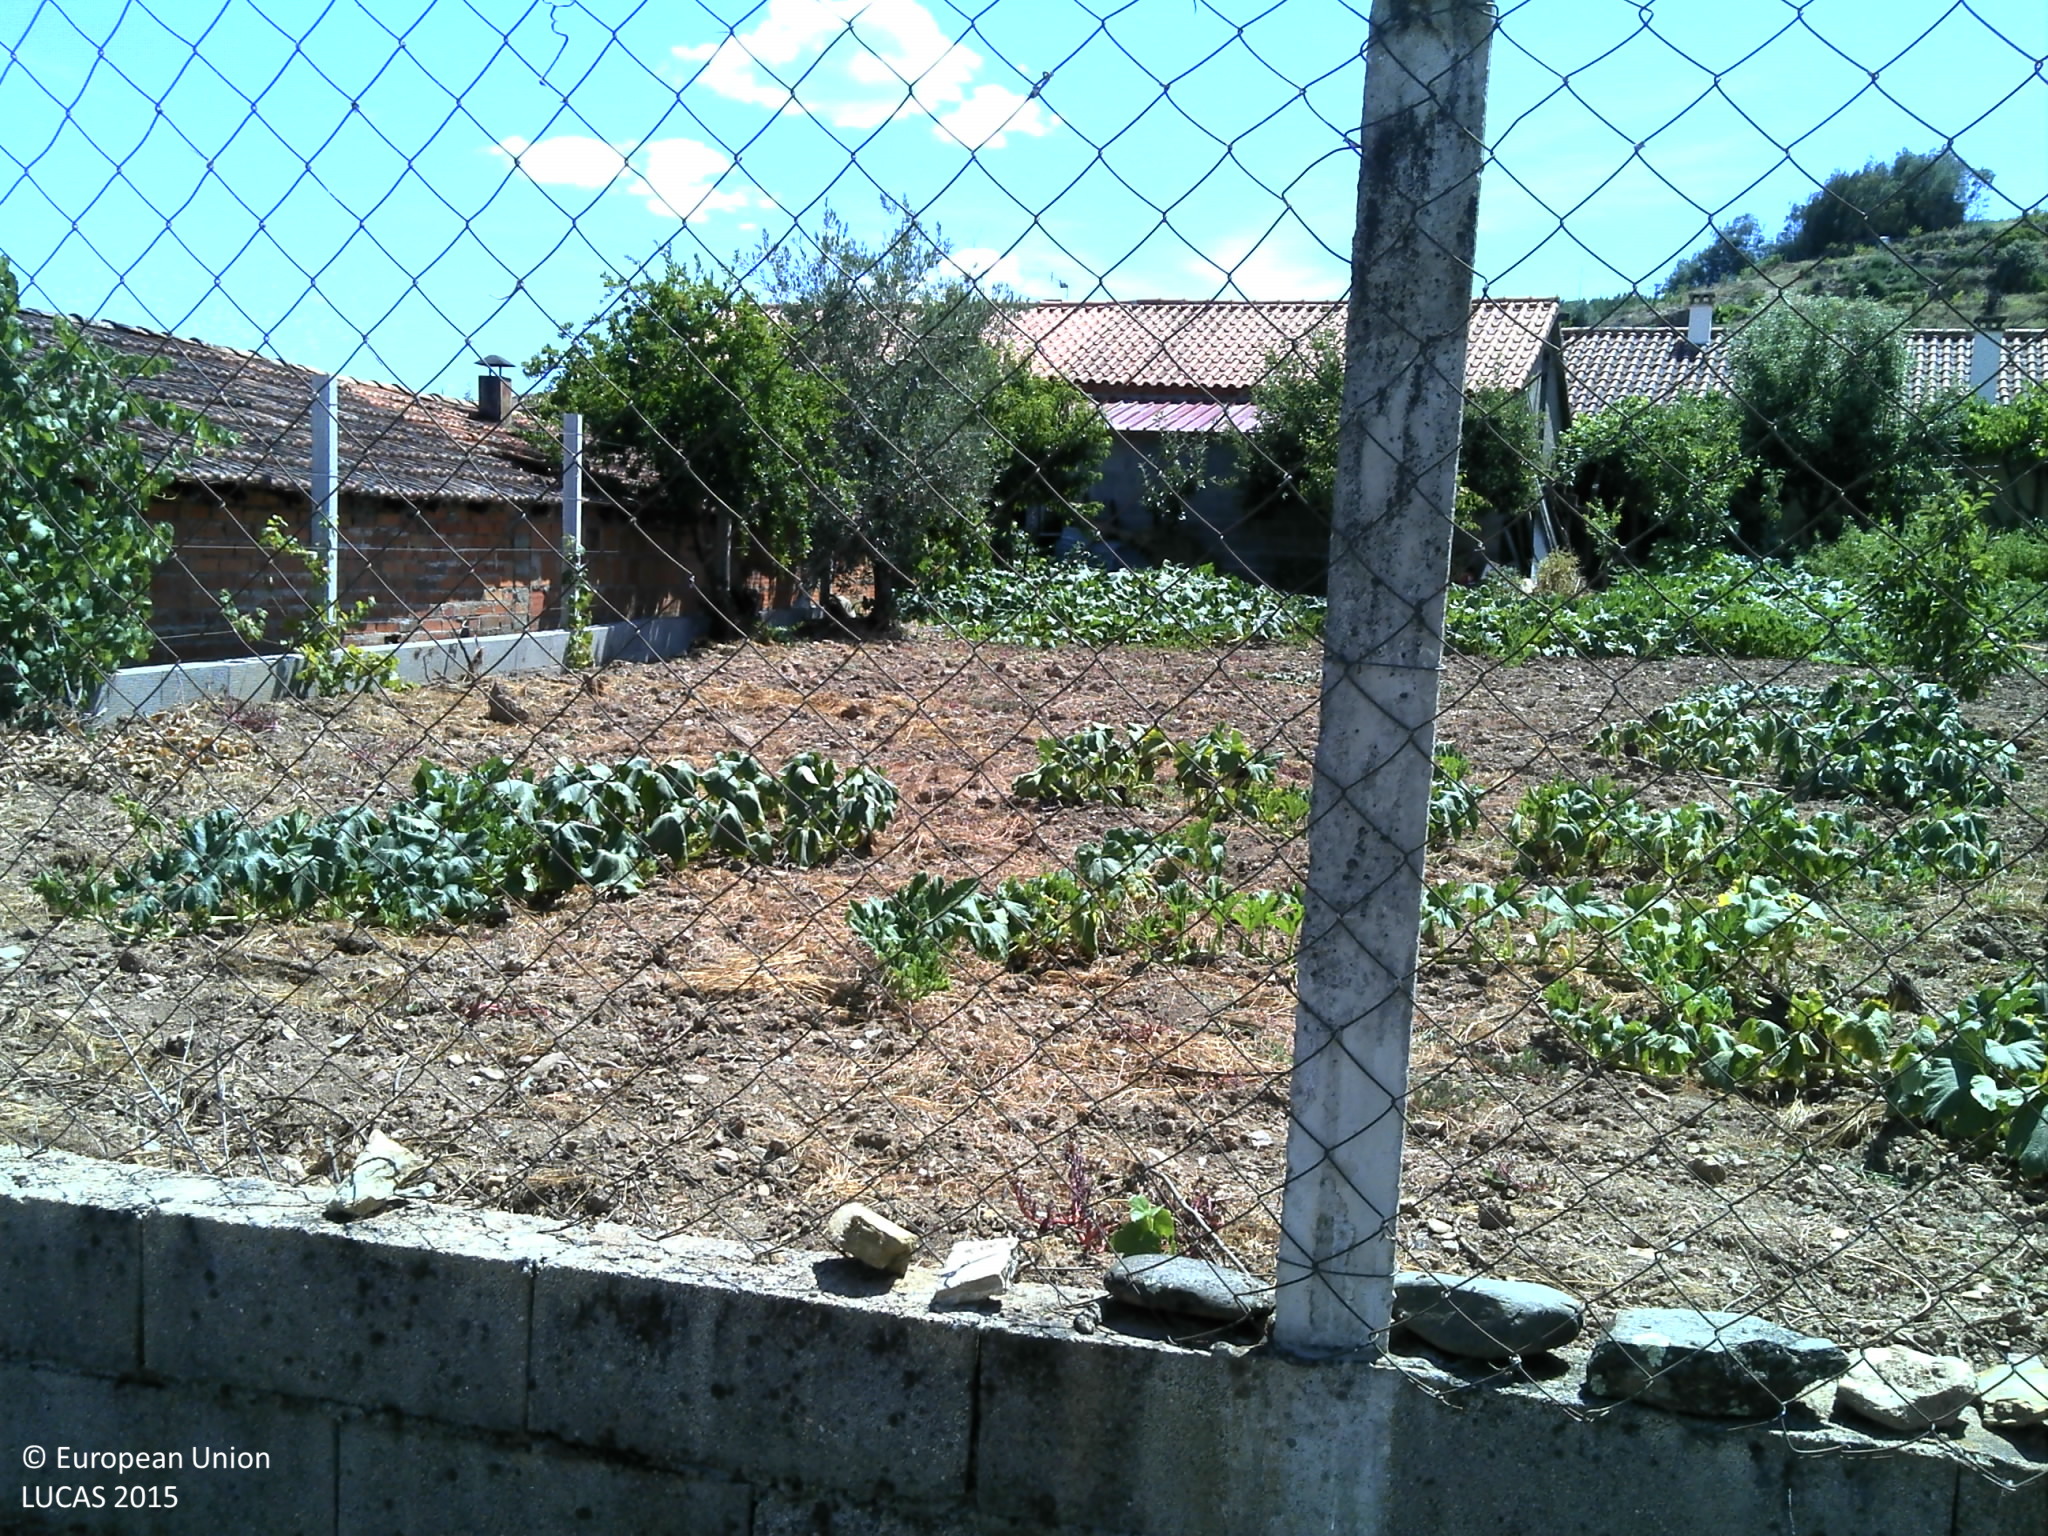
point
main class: Cropland
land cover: Apple fruit
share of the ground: 10 - 25 %
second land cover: Other fresh vegetables
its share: 10 - 25 %
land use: Kitchen garden
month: July
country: PT
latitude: 39.8150
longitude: -7.7566
